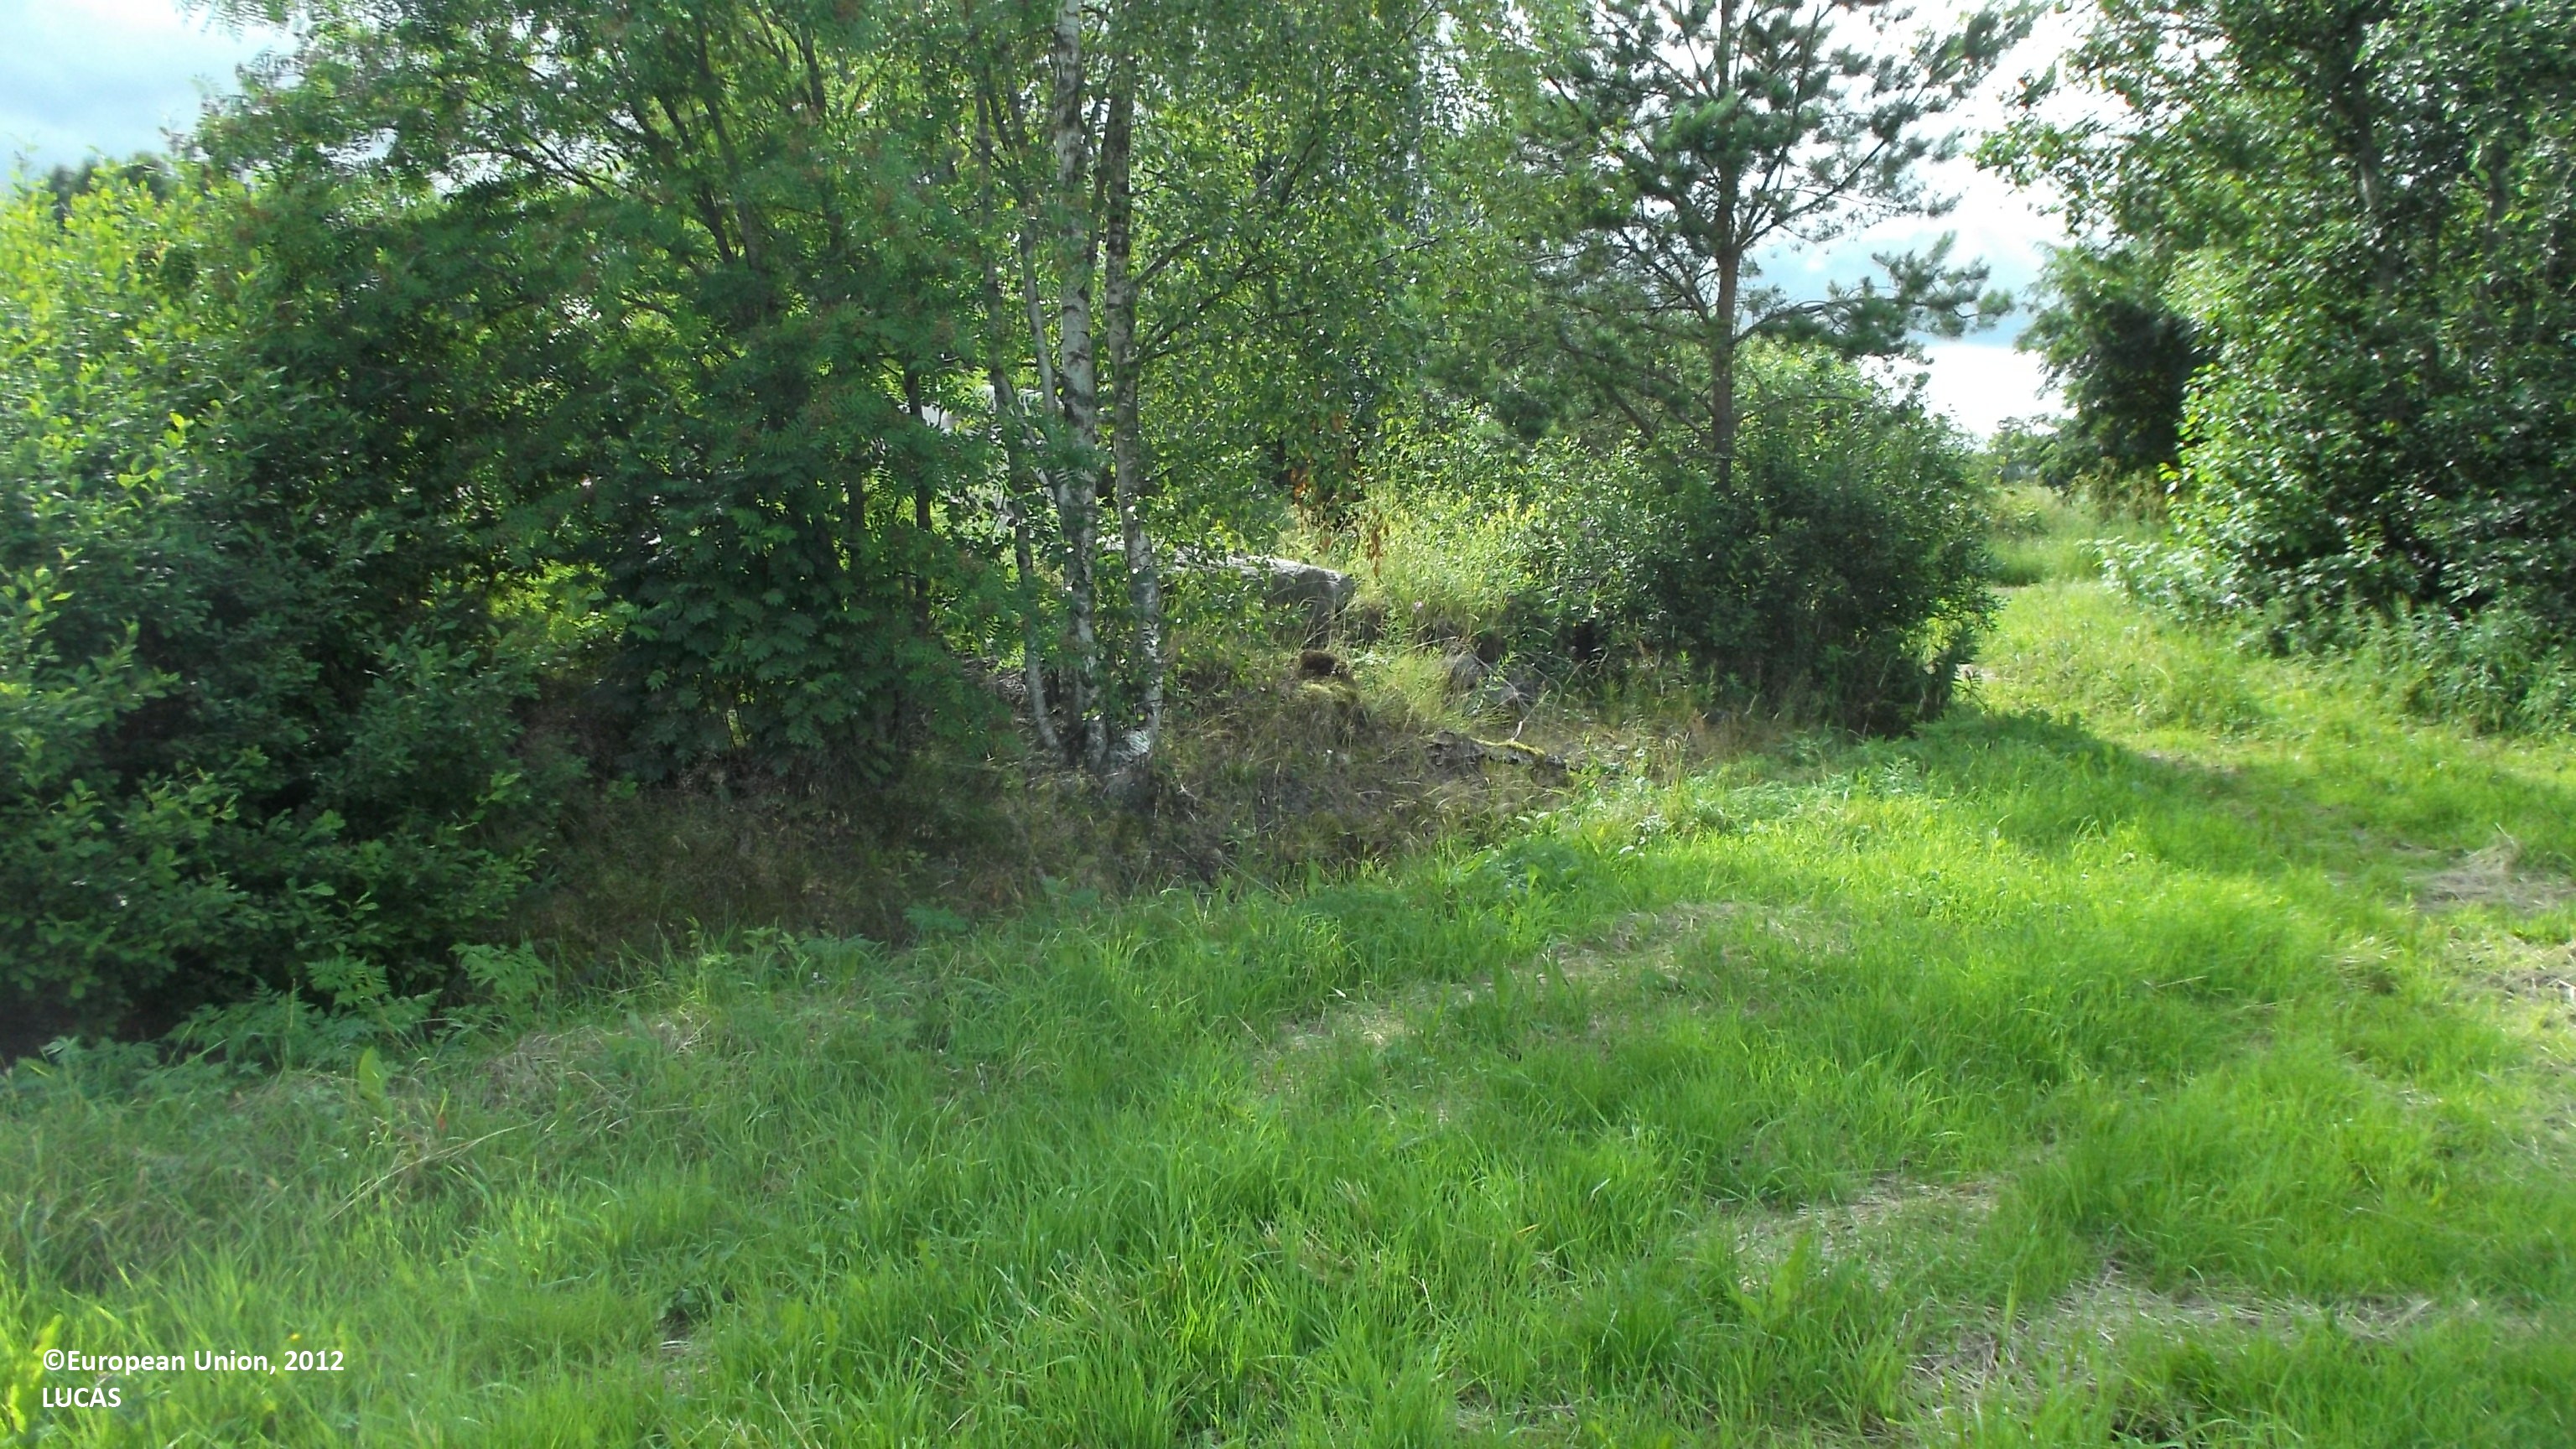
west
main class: Cropland
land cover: Temporary grasslands
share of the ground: > 75 %
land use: Agriculture (excluding fallow land and kitchen gardens)
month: July
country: FI
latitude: 63.7059
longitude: 23.3099
